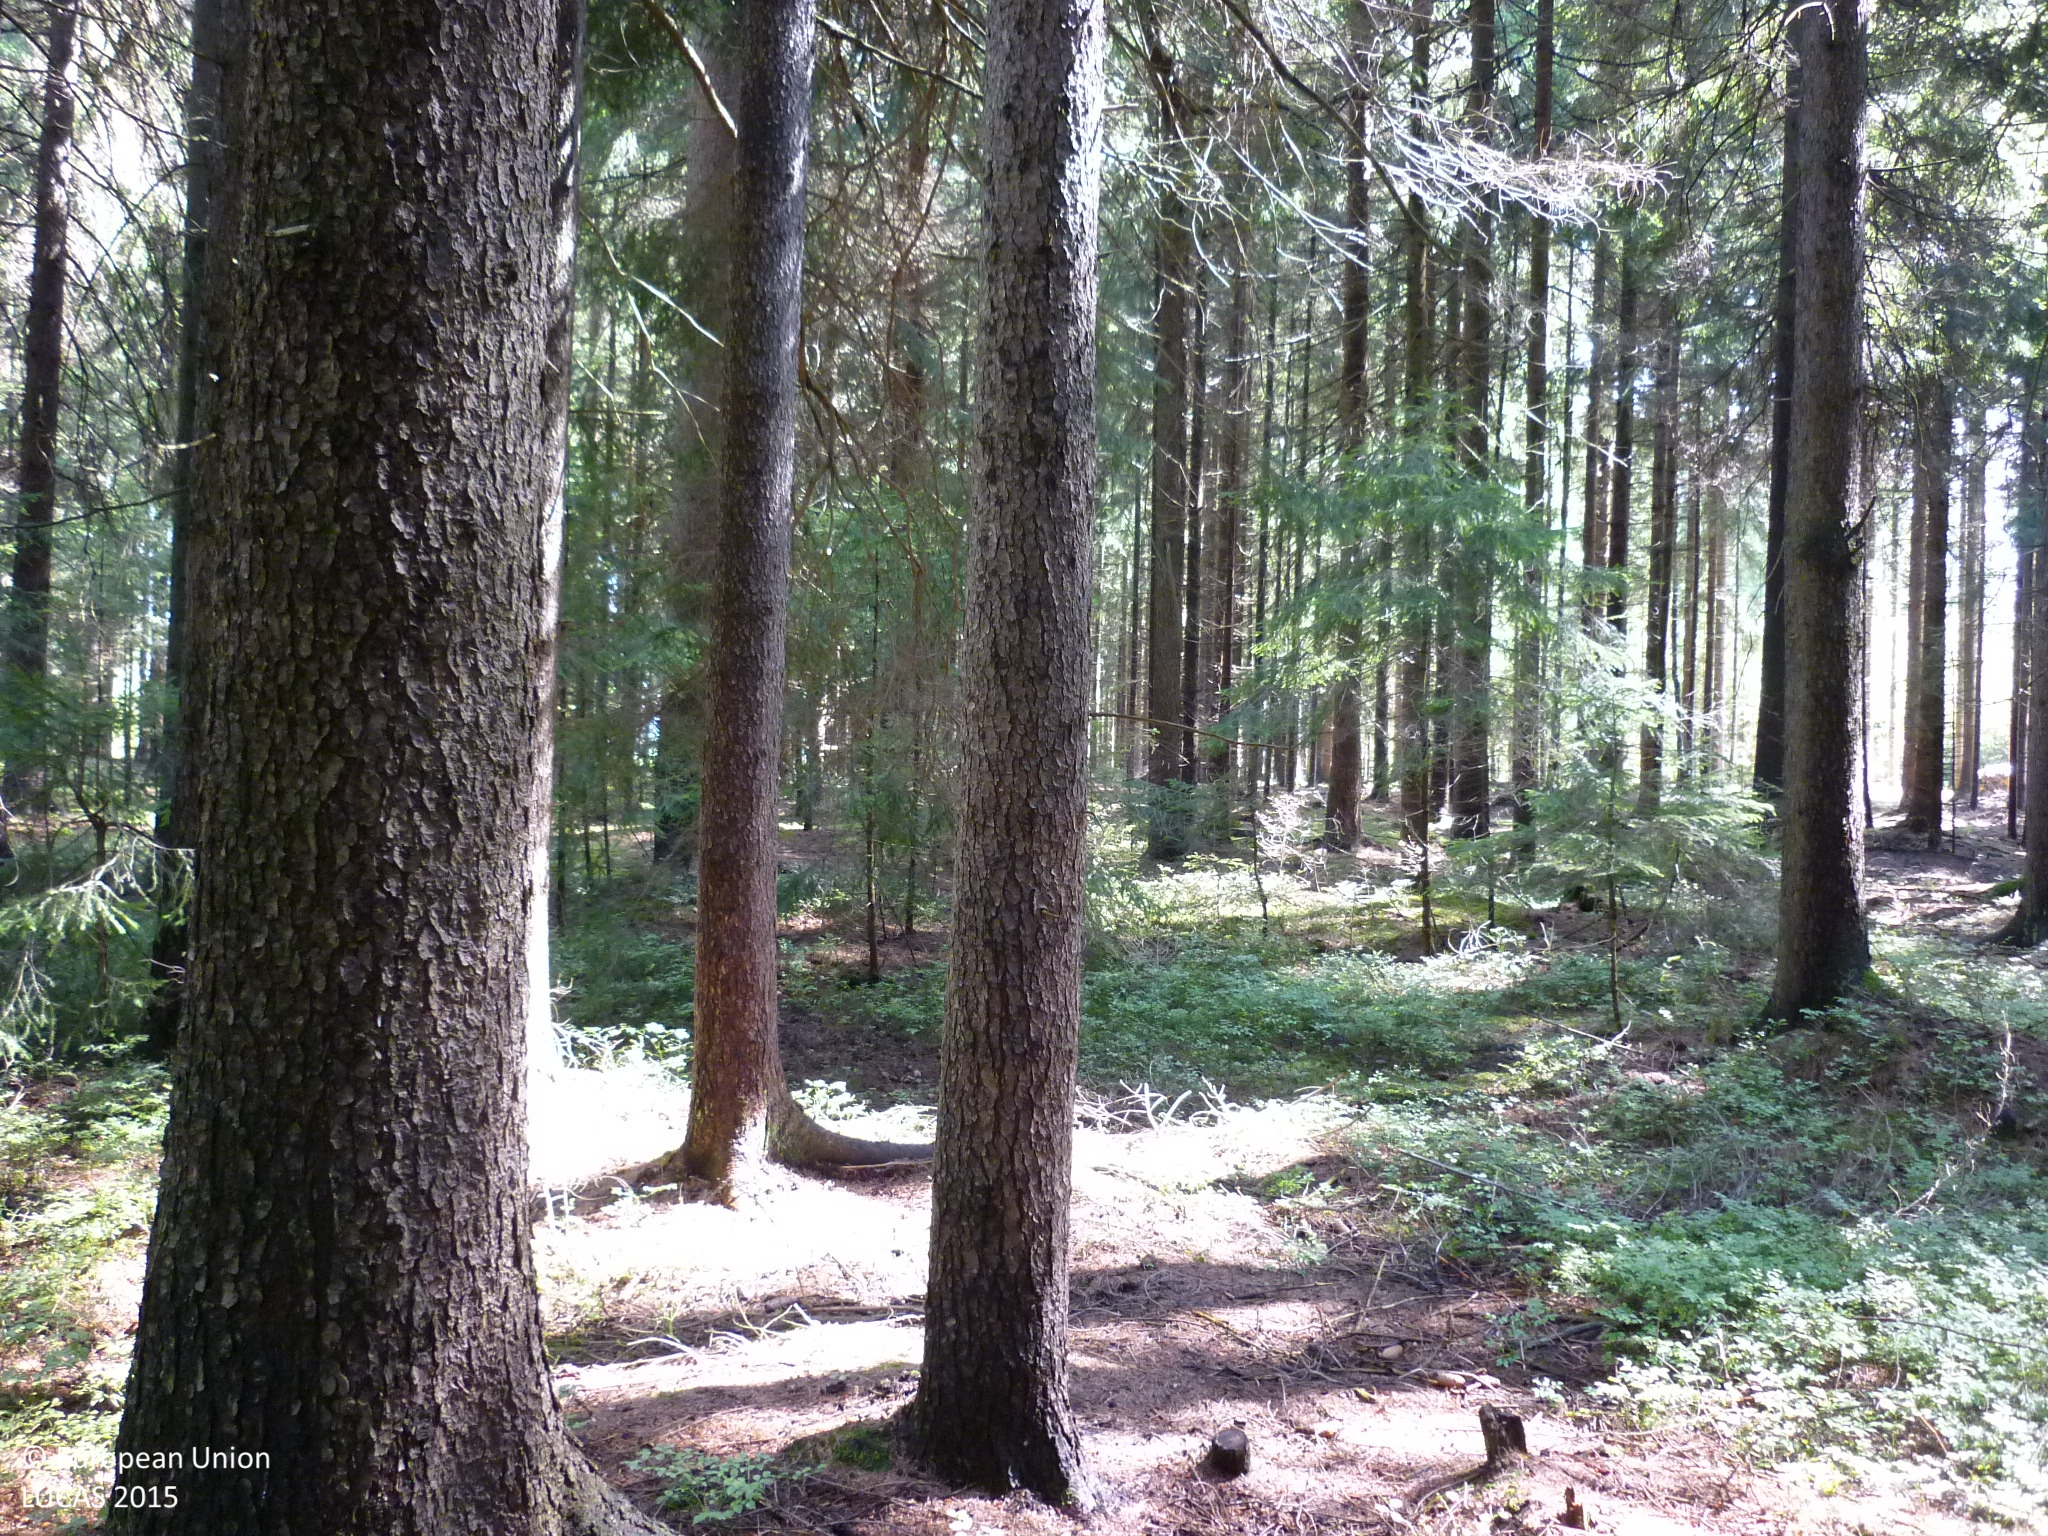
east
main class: Woodland
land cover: Spruce dominated coniferous woodland
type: hemiboreal forest and nemoral coniferous forest and mixed broadleaved-coniferous forest
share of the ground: > 75 %
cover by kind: coniferous forest trees 100 %
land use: Forestry
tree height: > 5 m
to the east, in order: Spruce dominated coniferous woodland; Tracks; Spruce dominated coniferous woodland; Spruce dominated mixed woodland; Grassland without tree/shrub cover
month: September
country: AT
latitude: 48.9877
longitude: 15.1269
